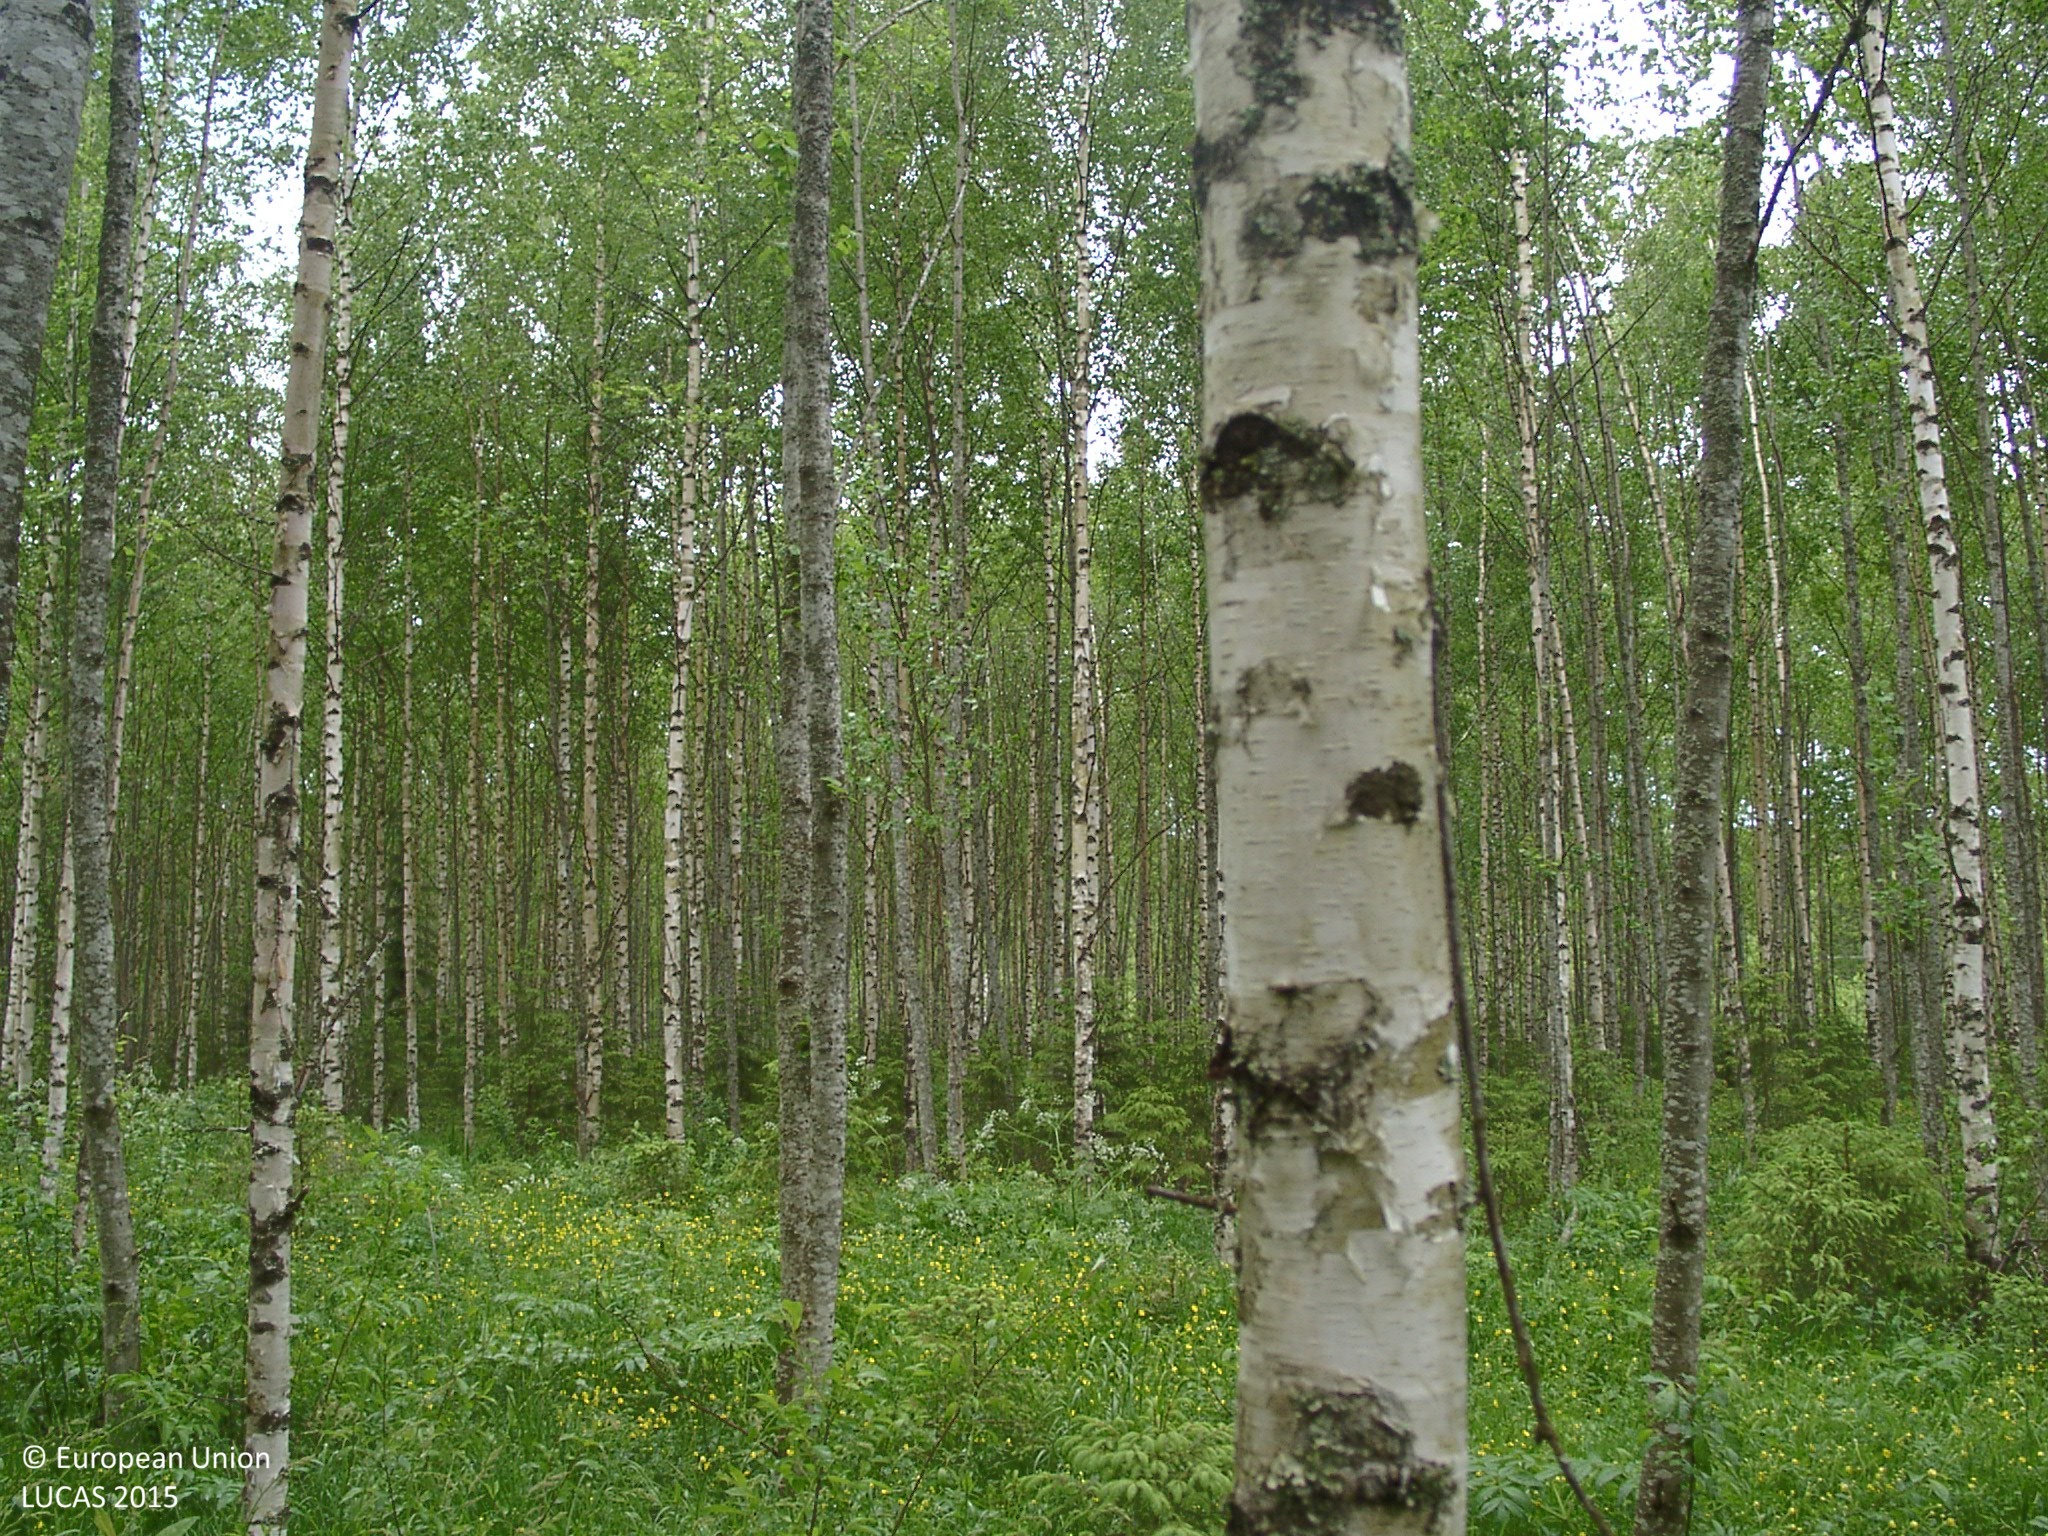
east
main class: Woodland
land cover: Broadleaved woodland
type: non-riverine alder, birch or aspen forest
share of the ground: 50 - 75 %
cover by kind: broadleaved forest trees 60 %, herbaceous plants 30 %, coniferous forest trees 5 %, shrubs 5 %
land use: Forestry
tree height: > 5 m
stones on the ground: < 10 %
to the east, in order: Broadleaved woodland; Shruby margins; Ditches and canals; Paved roads, cycling and walking lanes; Ditches and canals; Groves; Grassland without tree/shrub cover; Rivers and streams; Spruce dominated mixed woodland; Electric lines; Grassland with sparse tree/shrub cover; Spruce dominated coniferous woodland
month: June
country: FI
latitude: 61.8308
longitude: 24.5082
